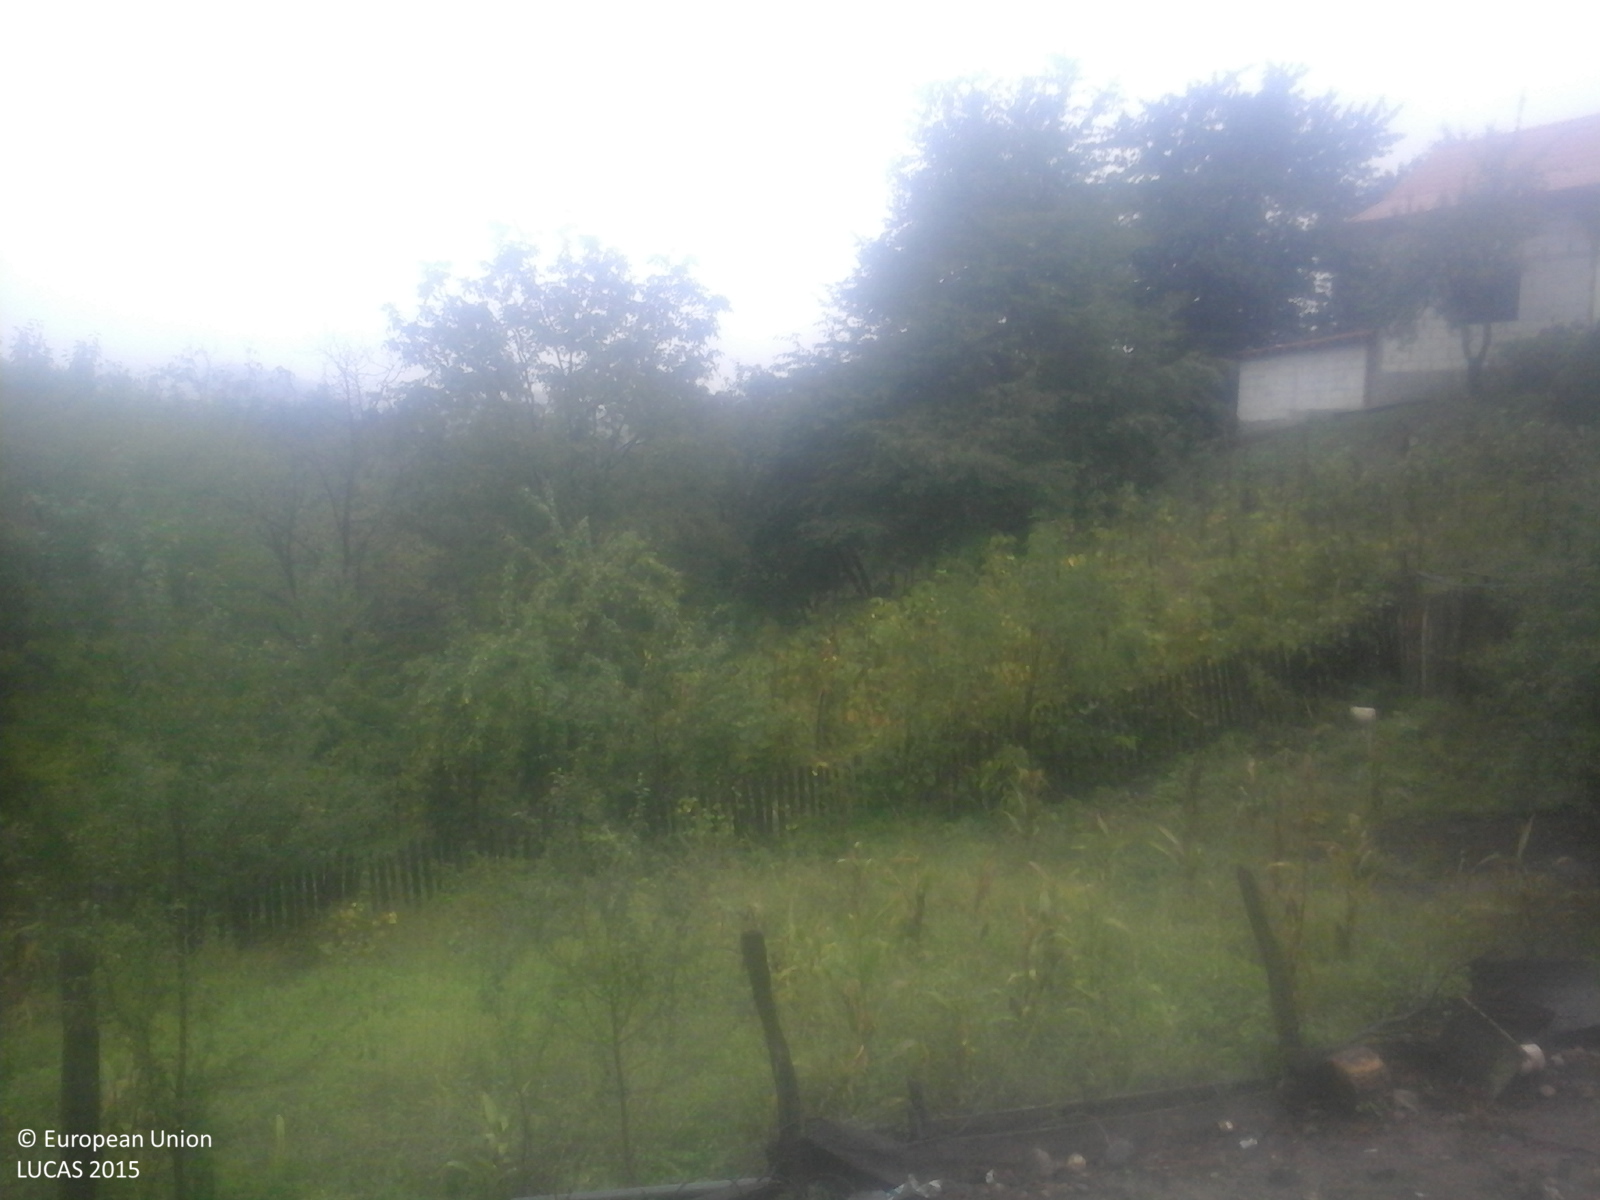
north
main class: Grassland
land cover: Spontaneously vegetated surfaces
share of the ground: > 75 %
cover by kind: herbaceous plants 100 %
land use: Fallow land
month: September
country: RO
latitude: 44.9772
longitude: 23.7955
